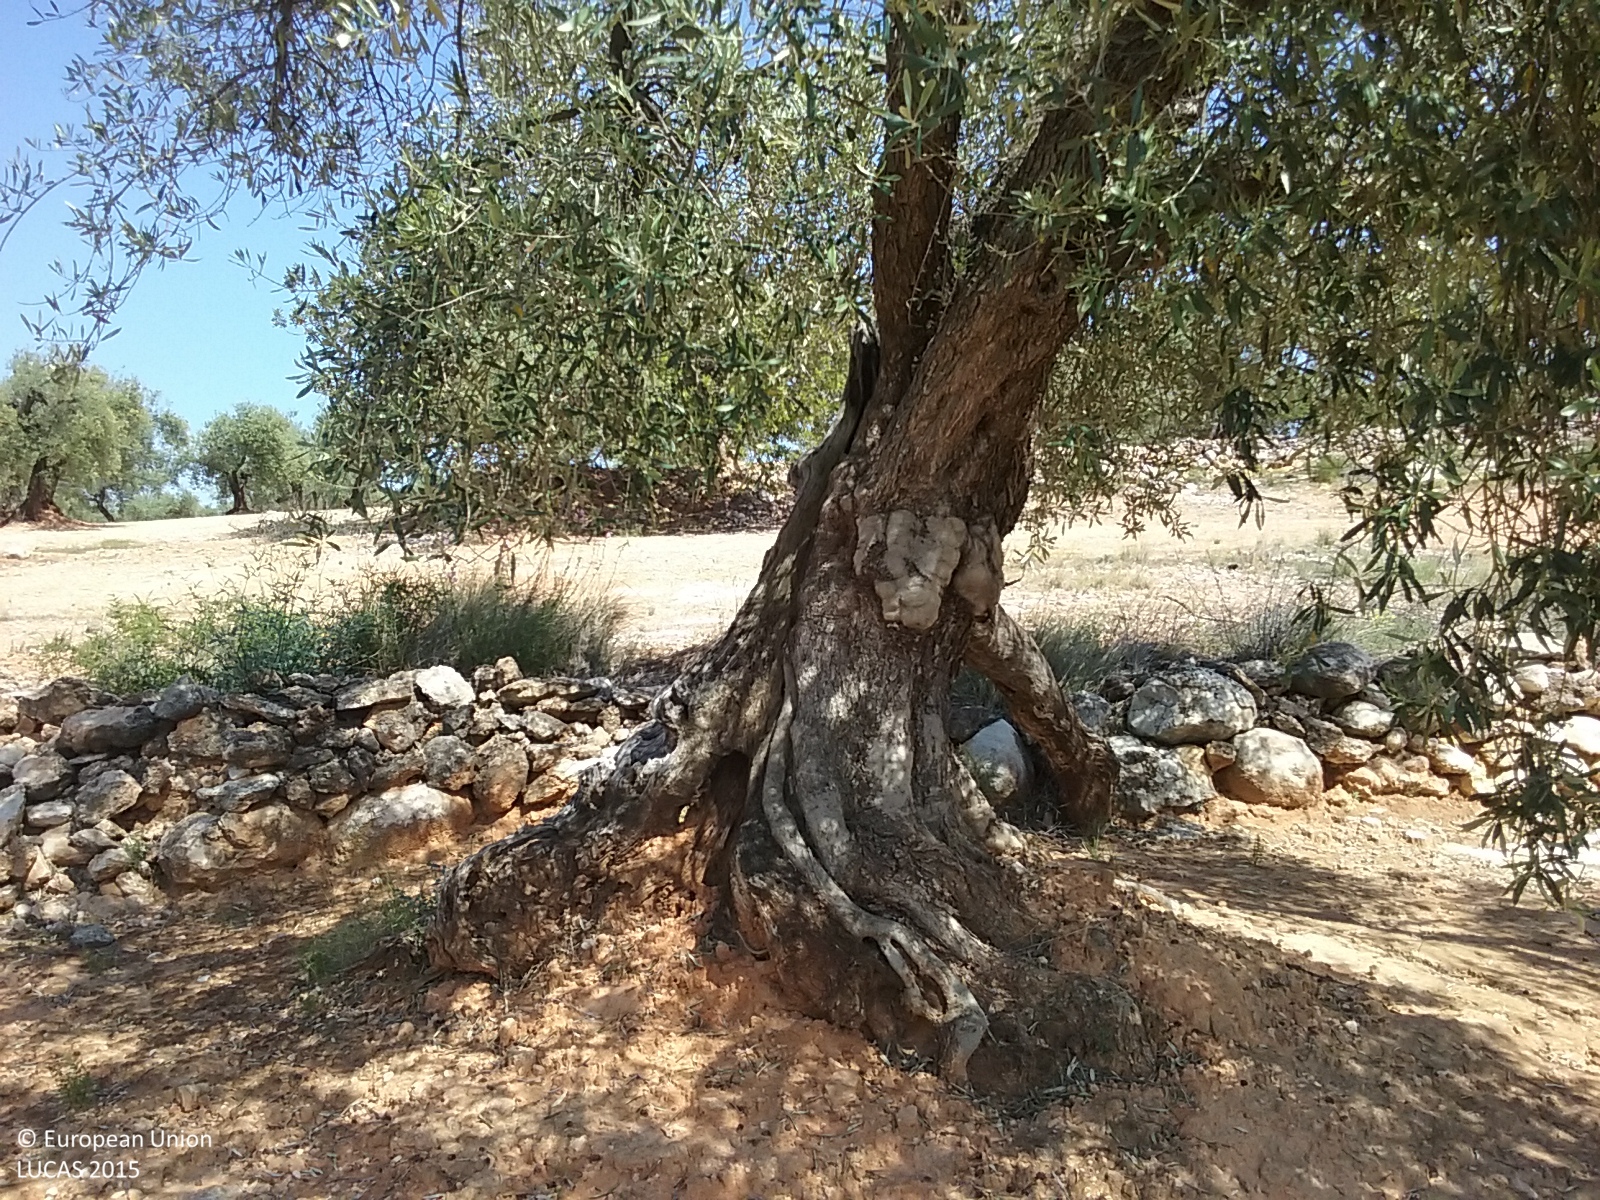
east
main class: Cropland
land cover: Olive groves
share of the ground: 25 - 50 %
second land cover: Other bare soil
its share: > 75 %
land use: Agriculture (excluding fallow land and kitchen gardens)
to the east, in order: Olive groves; Other bare soil; Dry stone walls; Olive groves; Dry stone walls; Olive groves; Dry stone walls; Tracks; Dry stone walls; Olive groves; Dry stone walls; Pine dominated mixed woodland
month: May
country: ES
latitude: 40.5660
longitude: 0.2742
